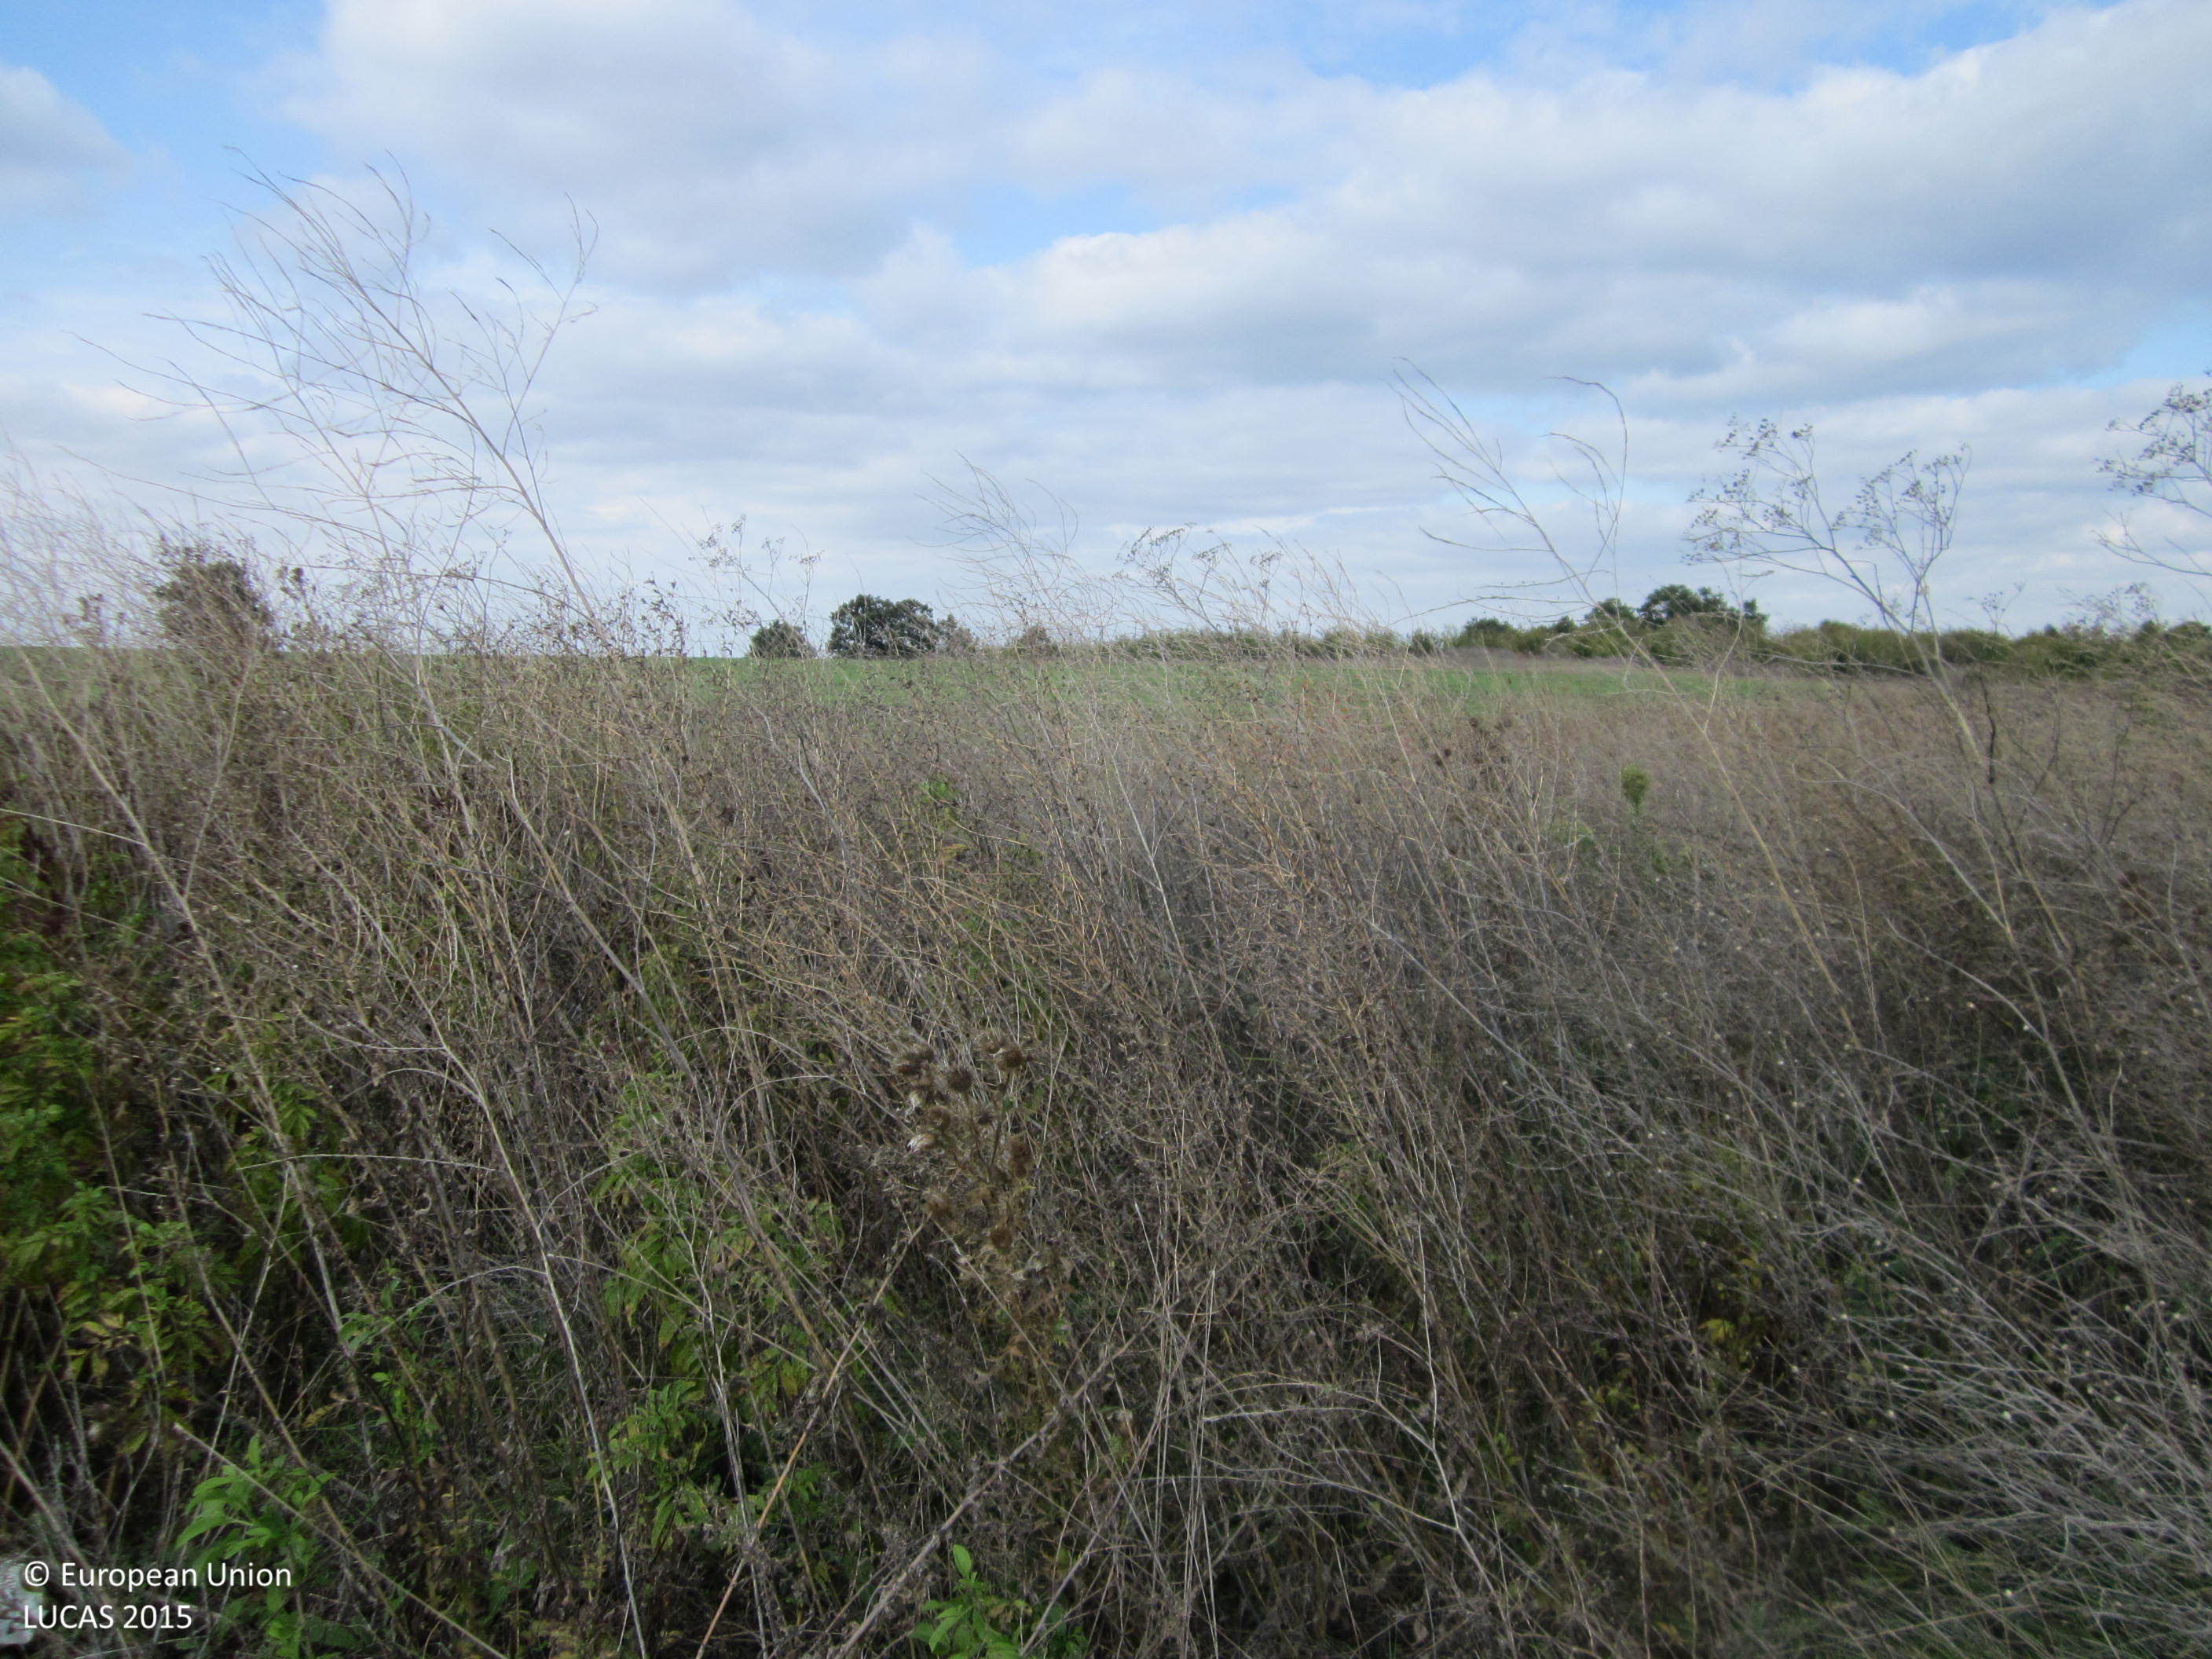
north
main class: Grassland
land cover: Spontaneously vegetated surfaces
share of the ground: > 75 %
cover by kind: herbaceous plants 100 %
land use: Fallow land
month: October
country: BG
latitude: 42.3442
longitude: 27.0117
